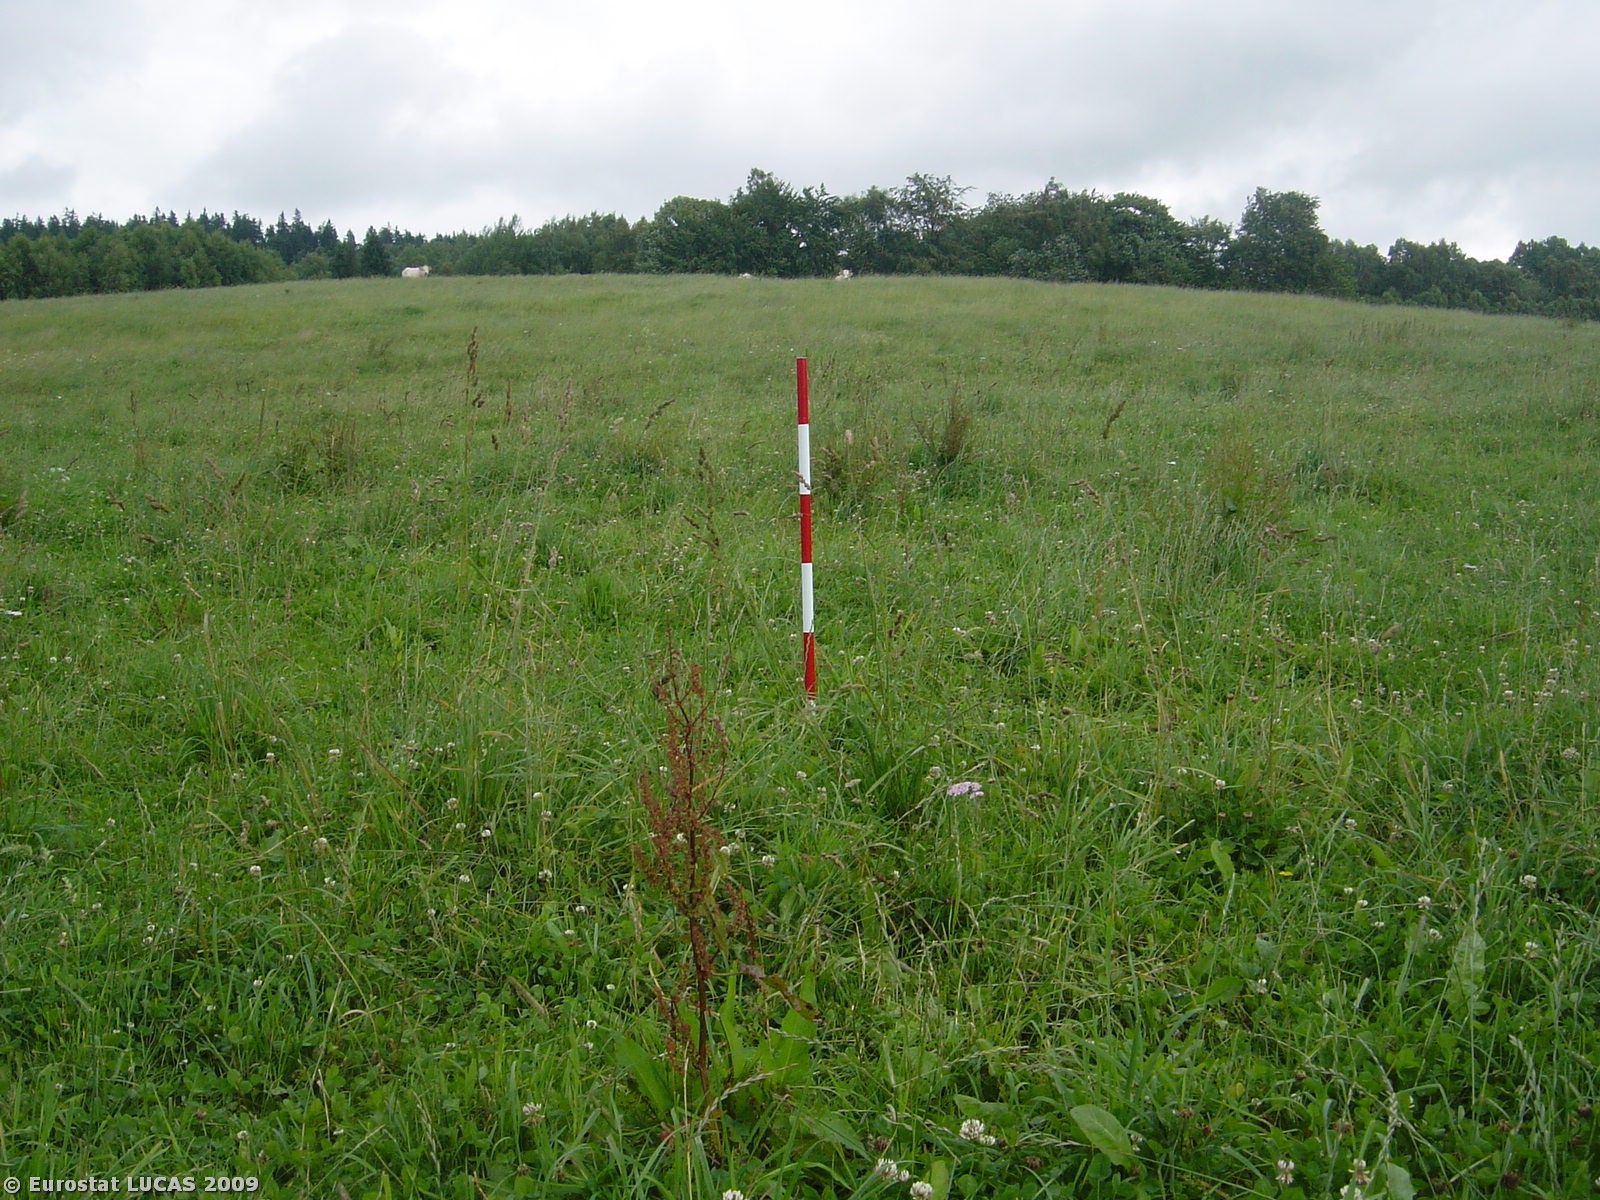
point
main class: Grassland
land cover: Grassland without tree/shrub cover
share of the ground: > 75 %
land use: Agriculture (excluding fallow land and kitchen gardens)
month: July
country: CZ
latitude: 49.7043
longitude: 12.6203
